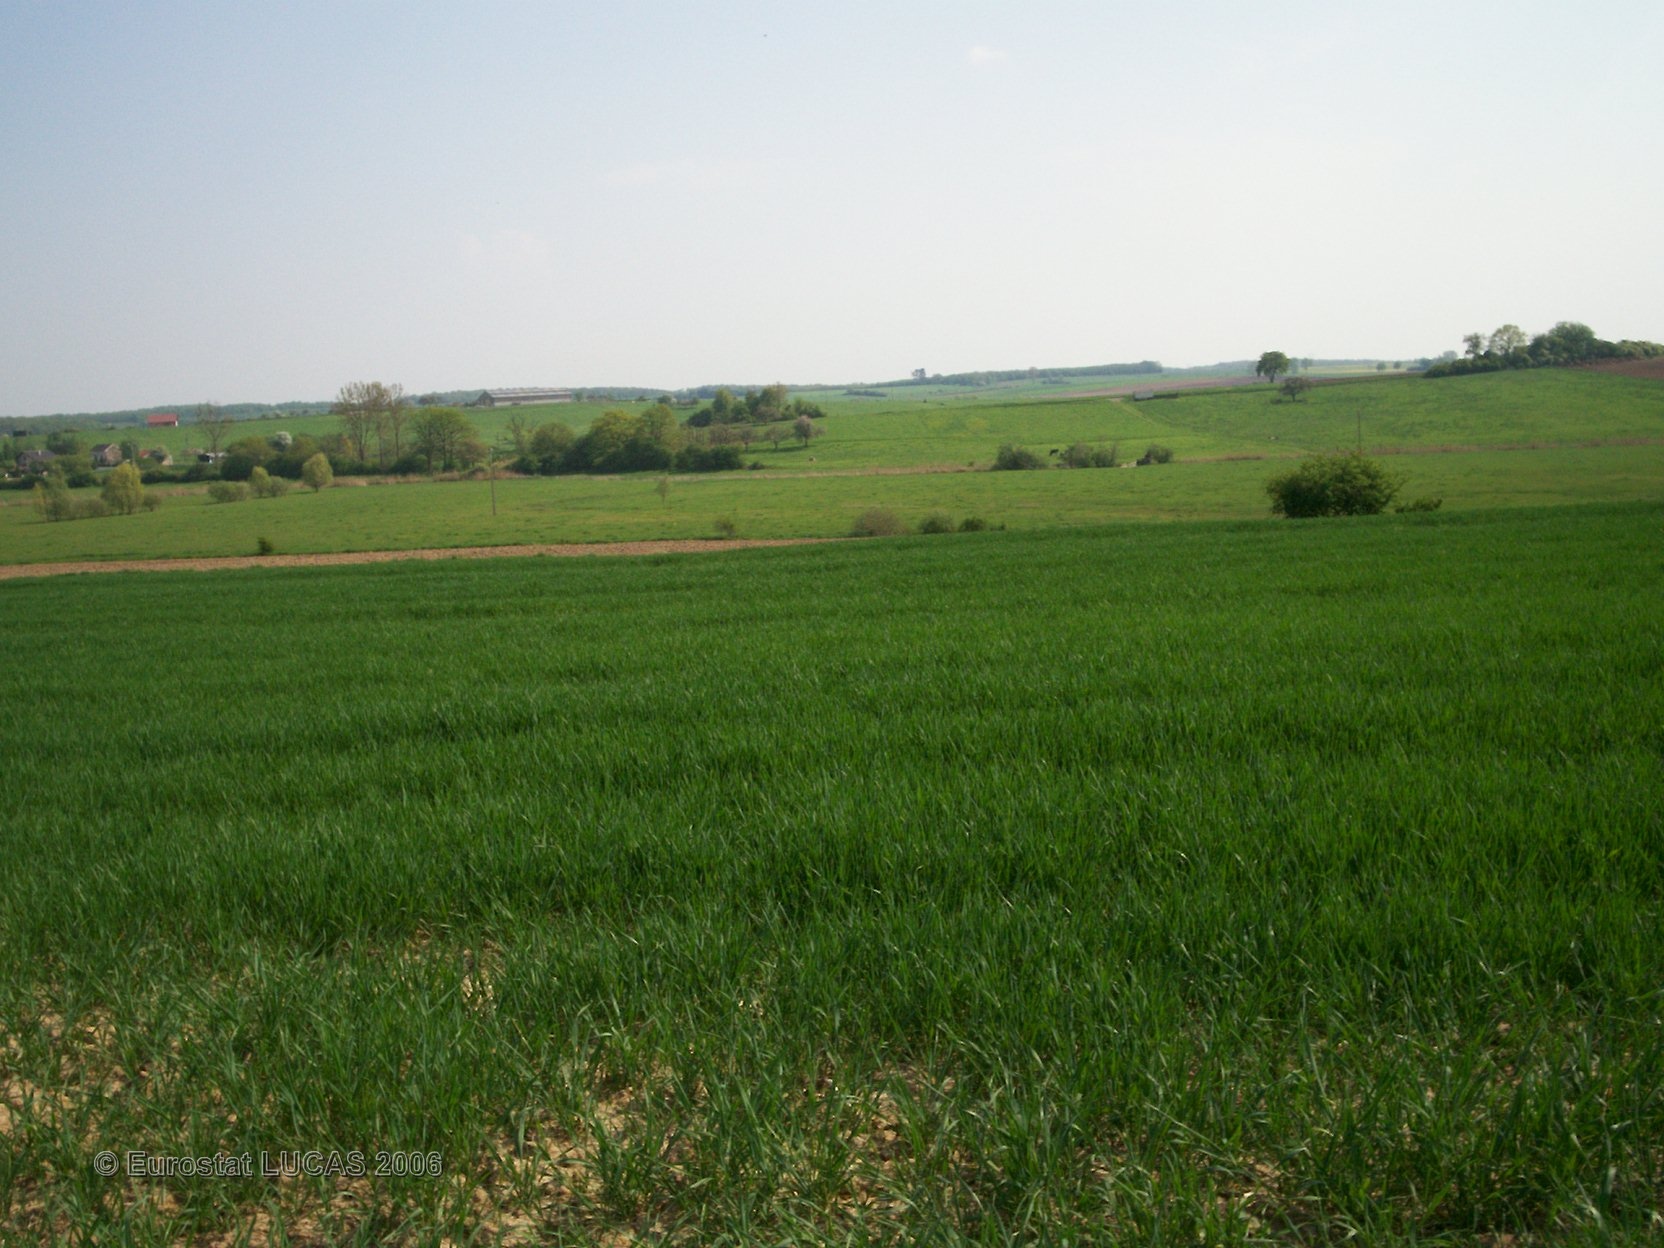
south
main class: Cropland
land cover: Common wheat
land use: Agriculture (excluding fallow land and kitchen gardens)
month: May
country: FR
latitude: 48.9190
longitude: 6.9299
